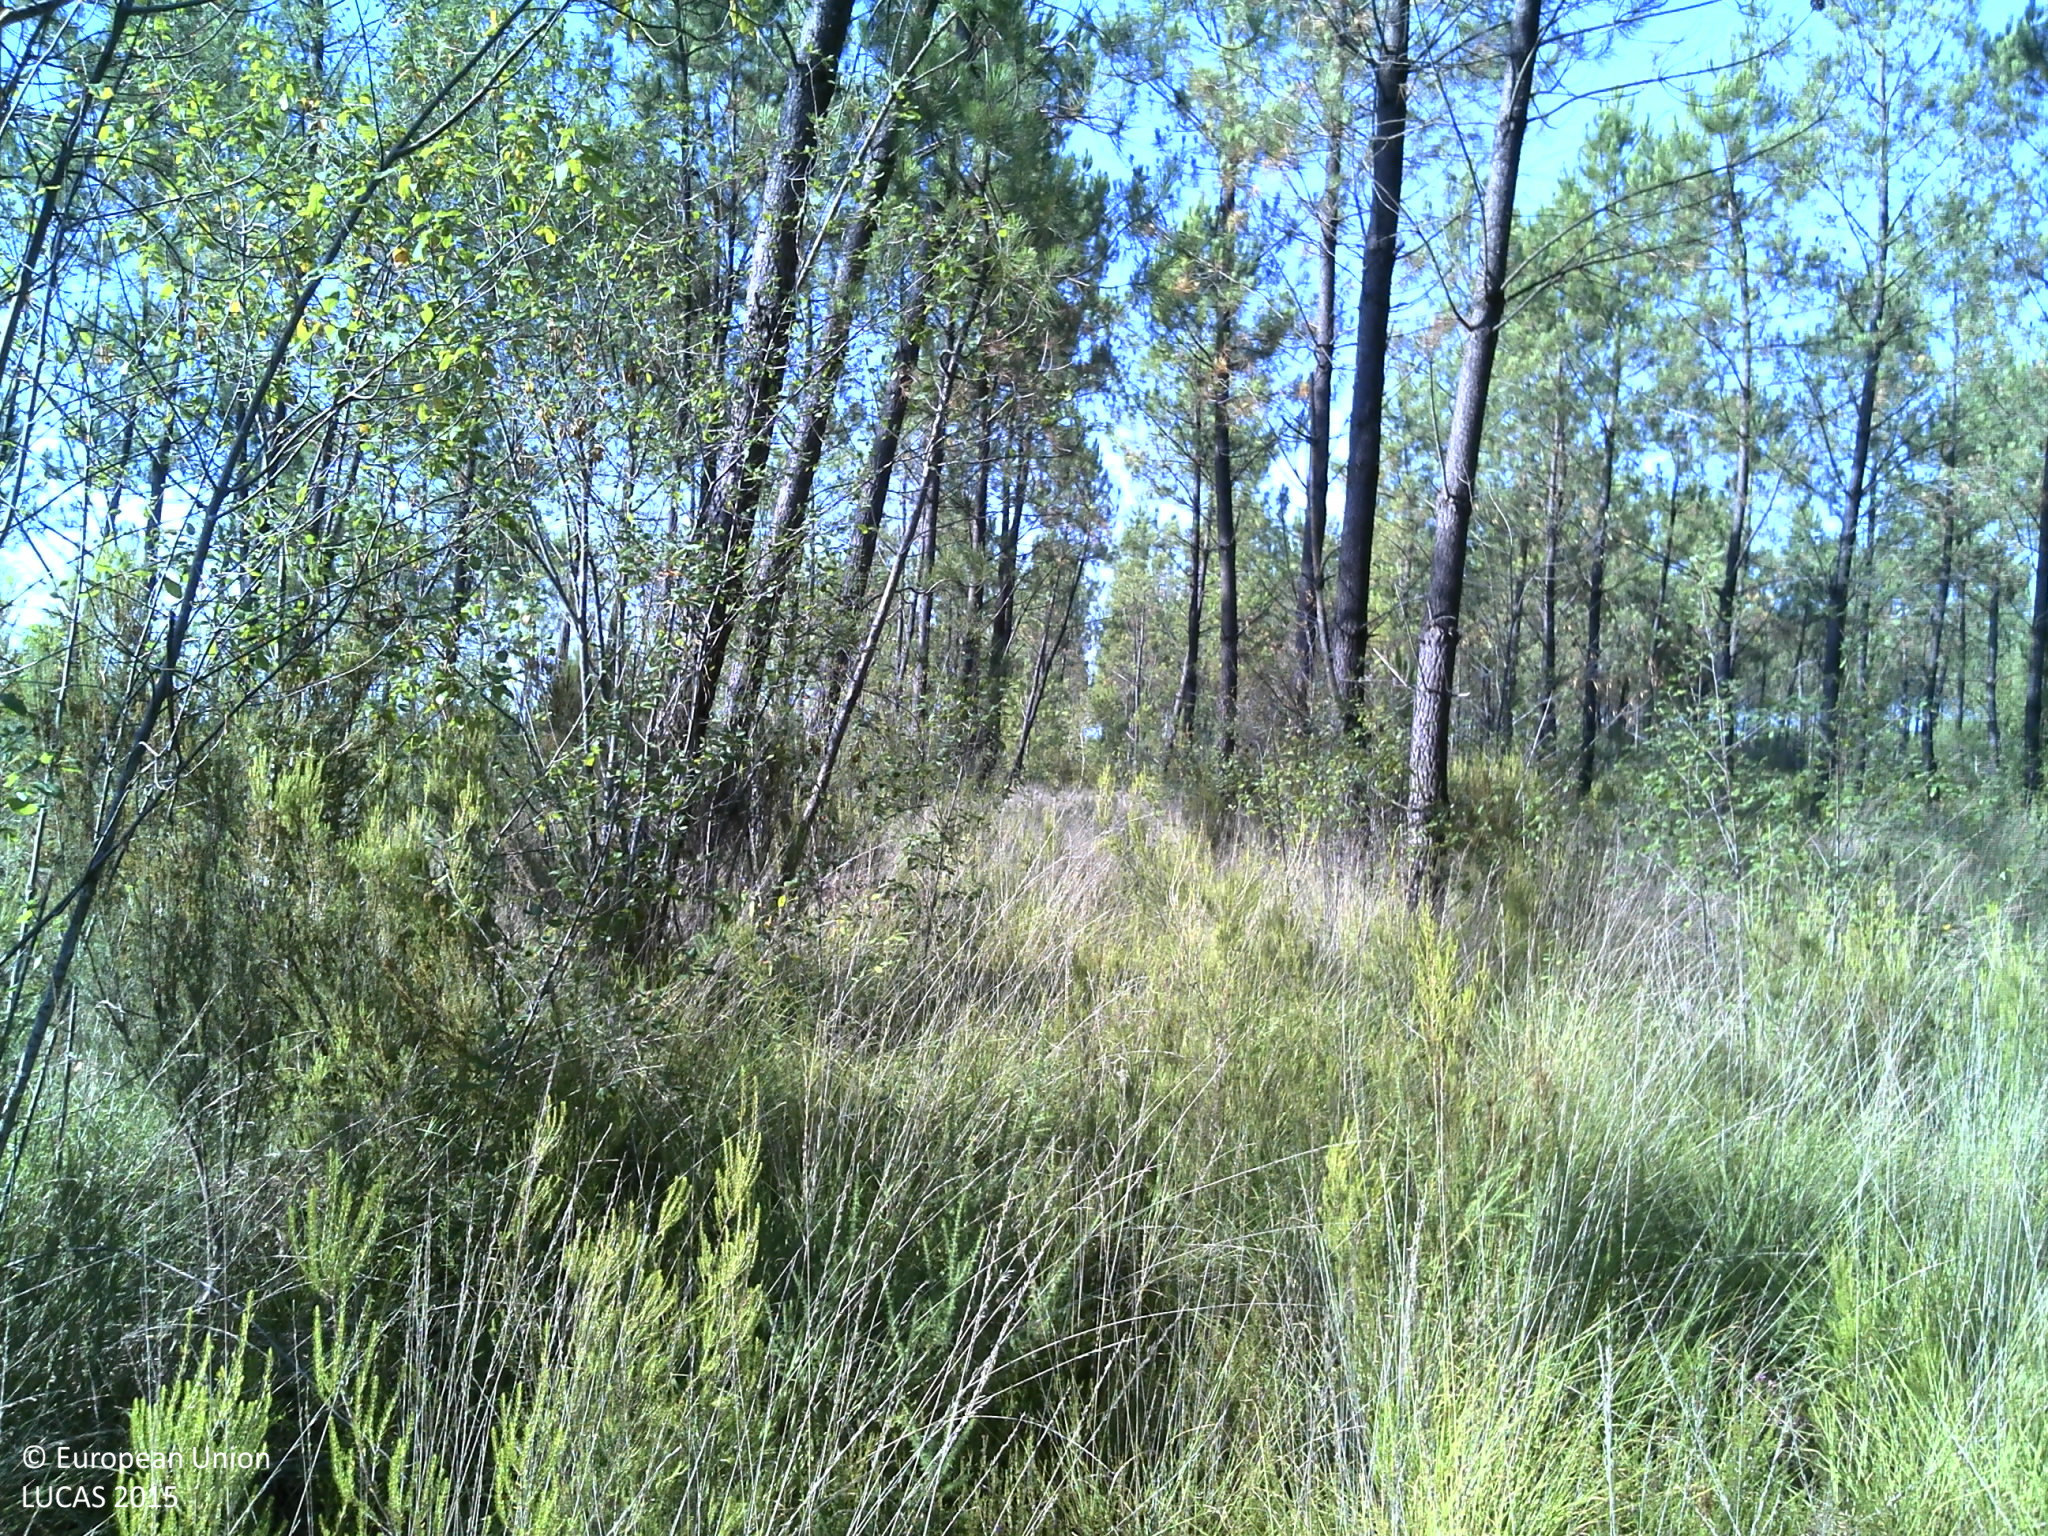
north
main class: Woodland
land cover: Pine dominated coniferous woodland
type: coniferous forest of the mediterranean region
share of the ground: > 75 %
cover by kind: coniferous forest trees 60 %, shrubs 30 %, herbaceous plants 5 %, lichens and mosses 5 %
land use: Forestry
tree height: > 5 m
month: July
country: FR
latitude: 44.5357
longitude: -0.5752
